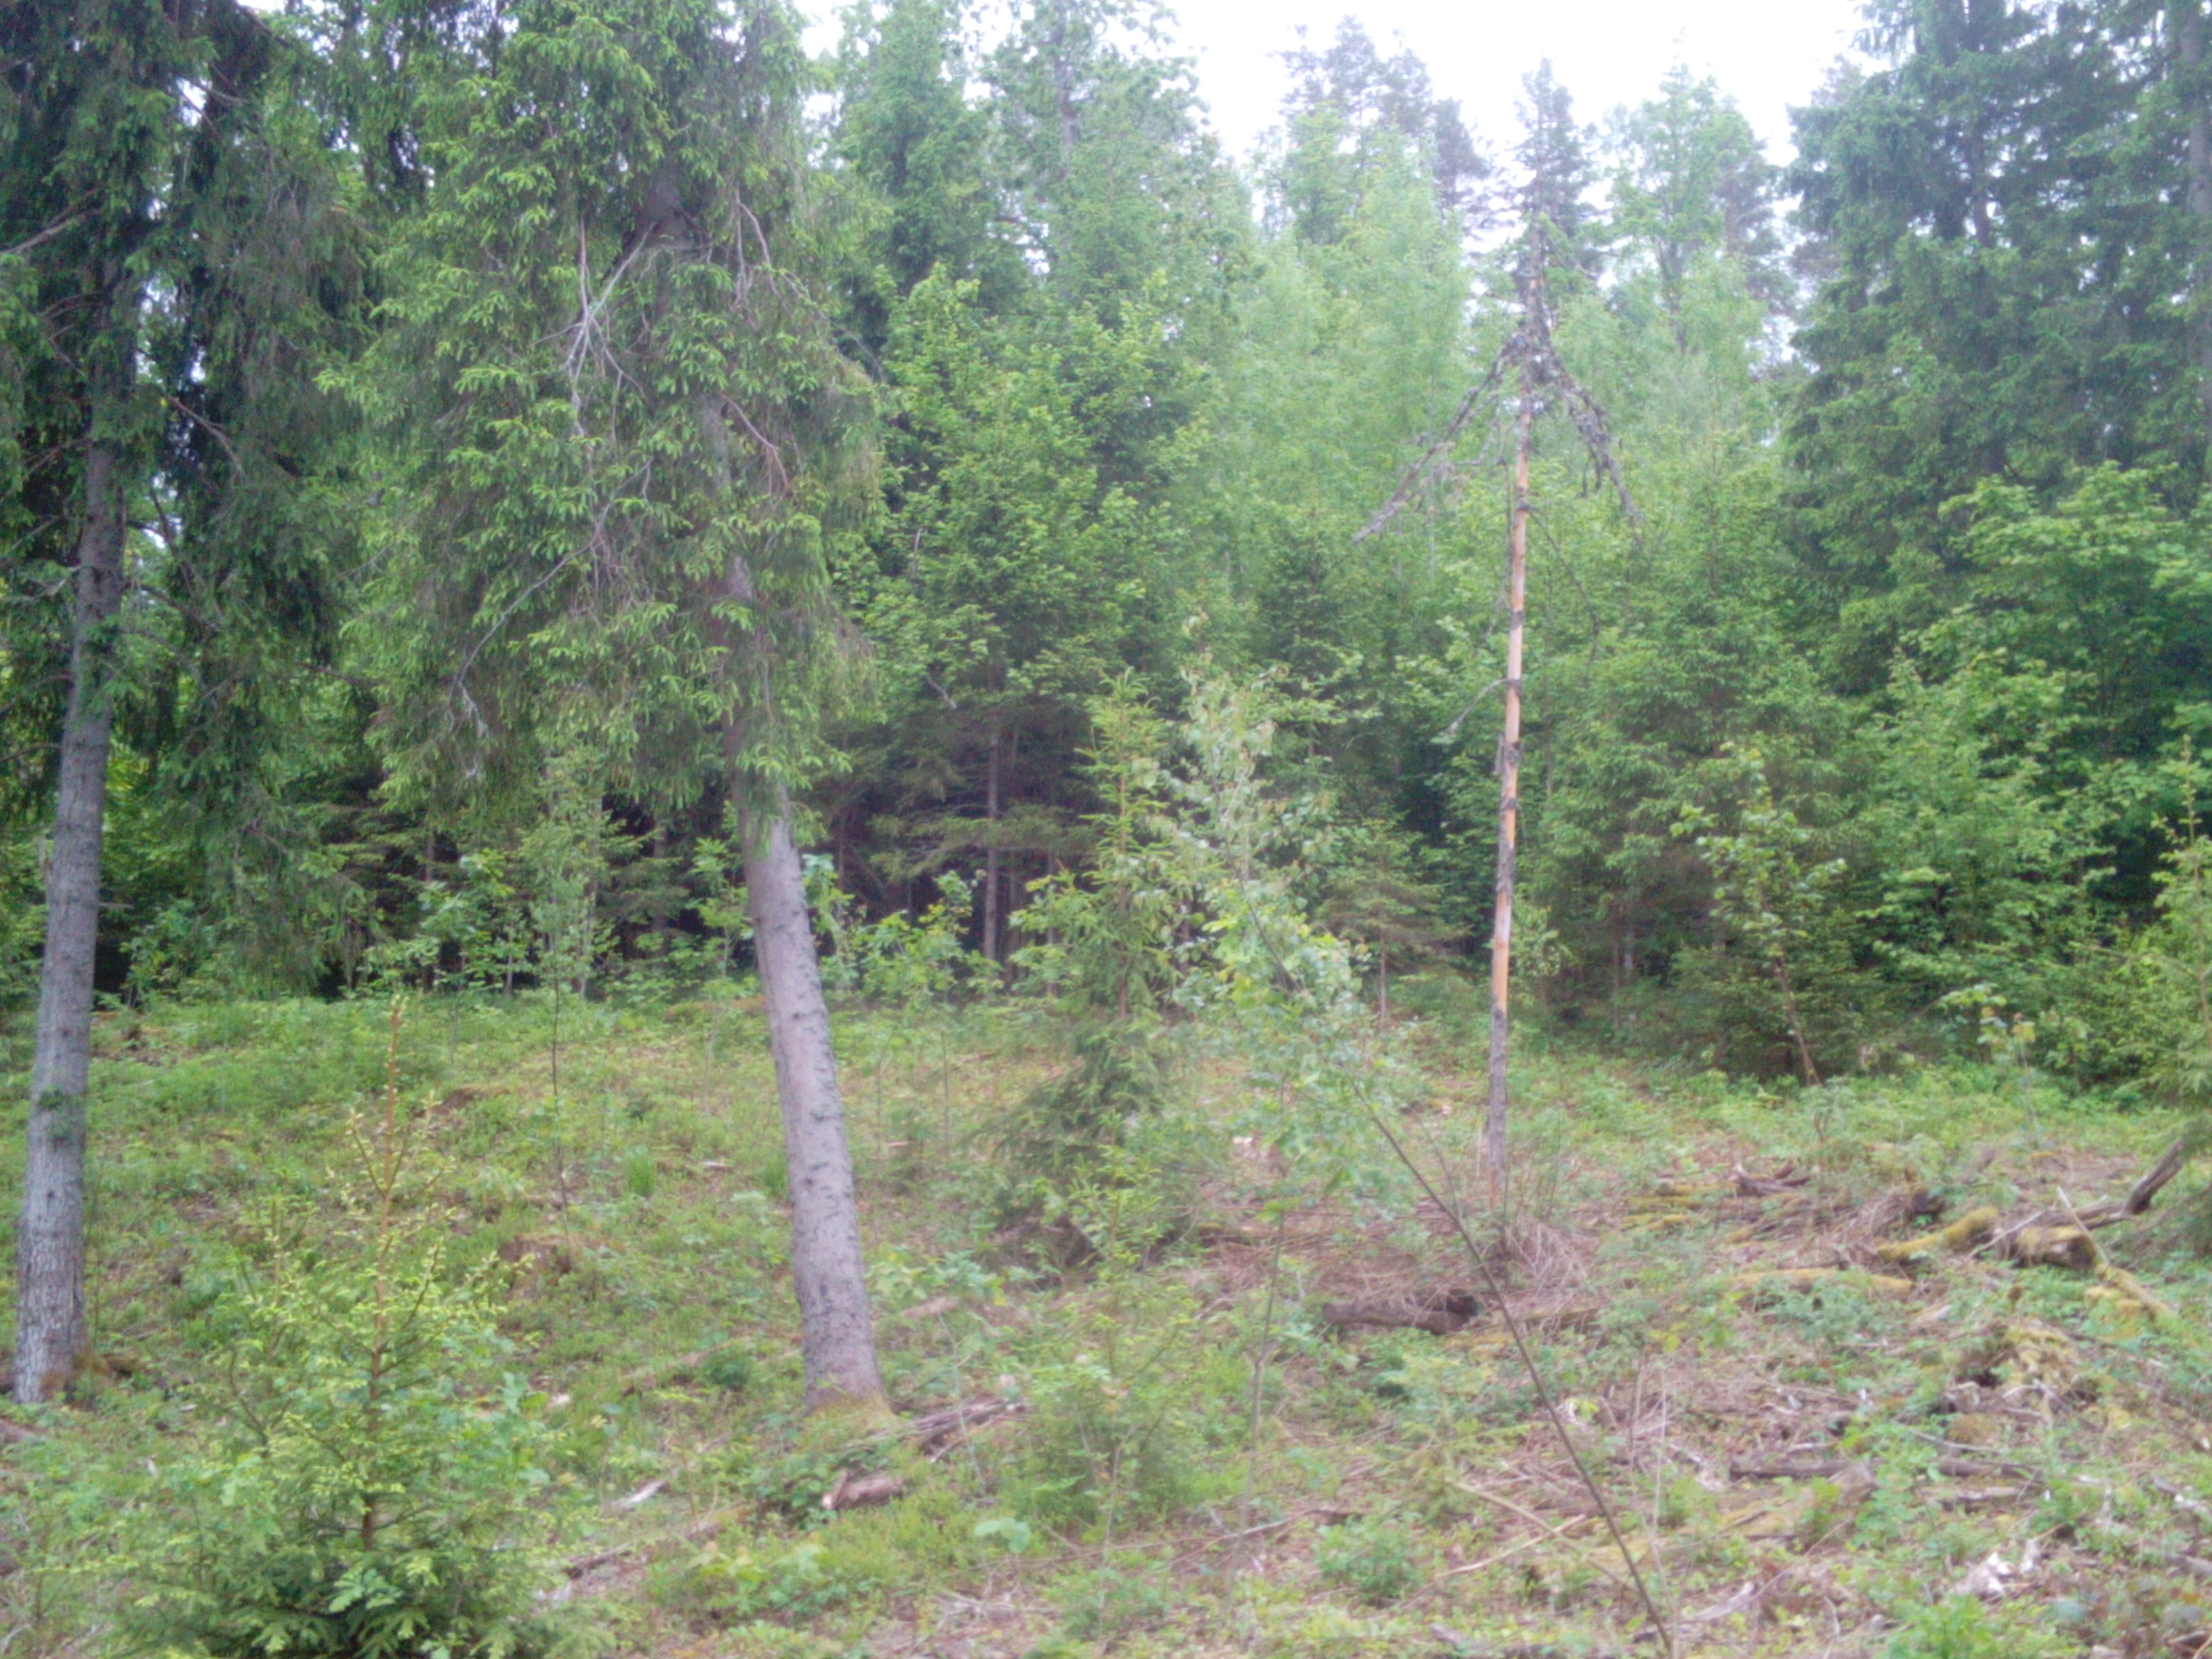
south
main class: Woodland
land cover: Spruce dominated mixed woodland
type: hemiboreal forest and nemoral coniferous forest and mixed broadleaved-coniferous forest
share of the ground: 25 - 50 %
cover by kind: herbaceous plants 35 %, coniferous forest trees 25 %, broadleaved forest trees 20 %, shrubs 15 %
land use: Forestry
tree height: > 5 m
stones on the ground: 10 - 25 %
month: June
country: LV
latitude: 56.8509
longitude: 21.9016
